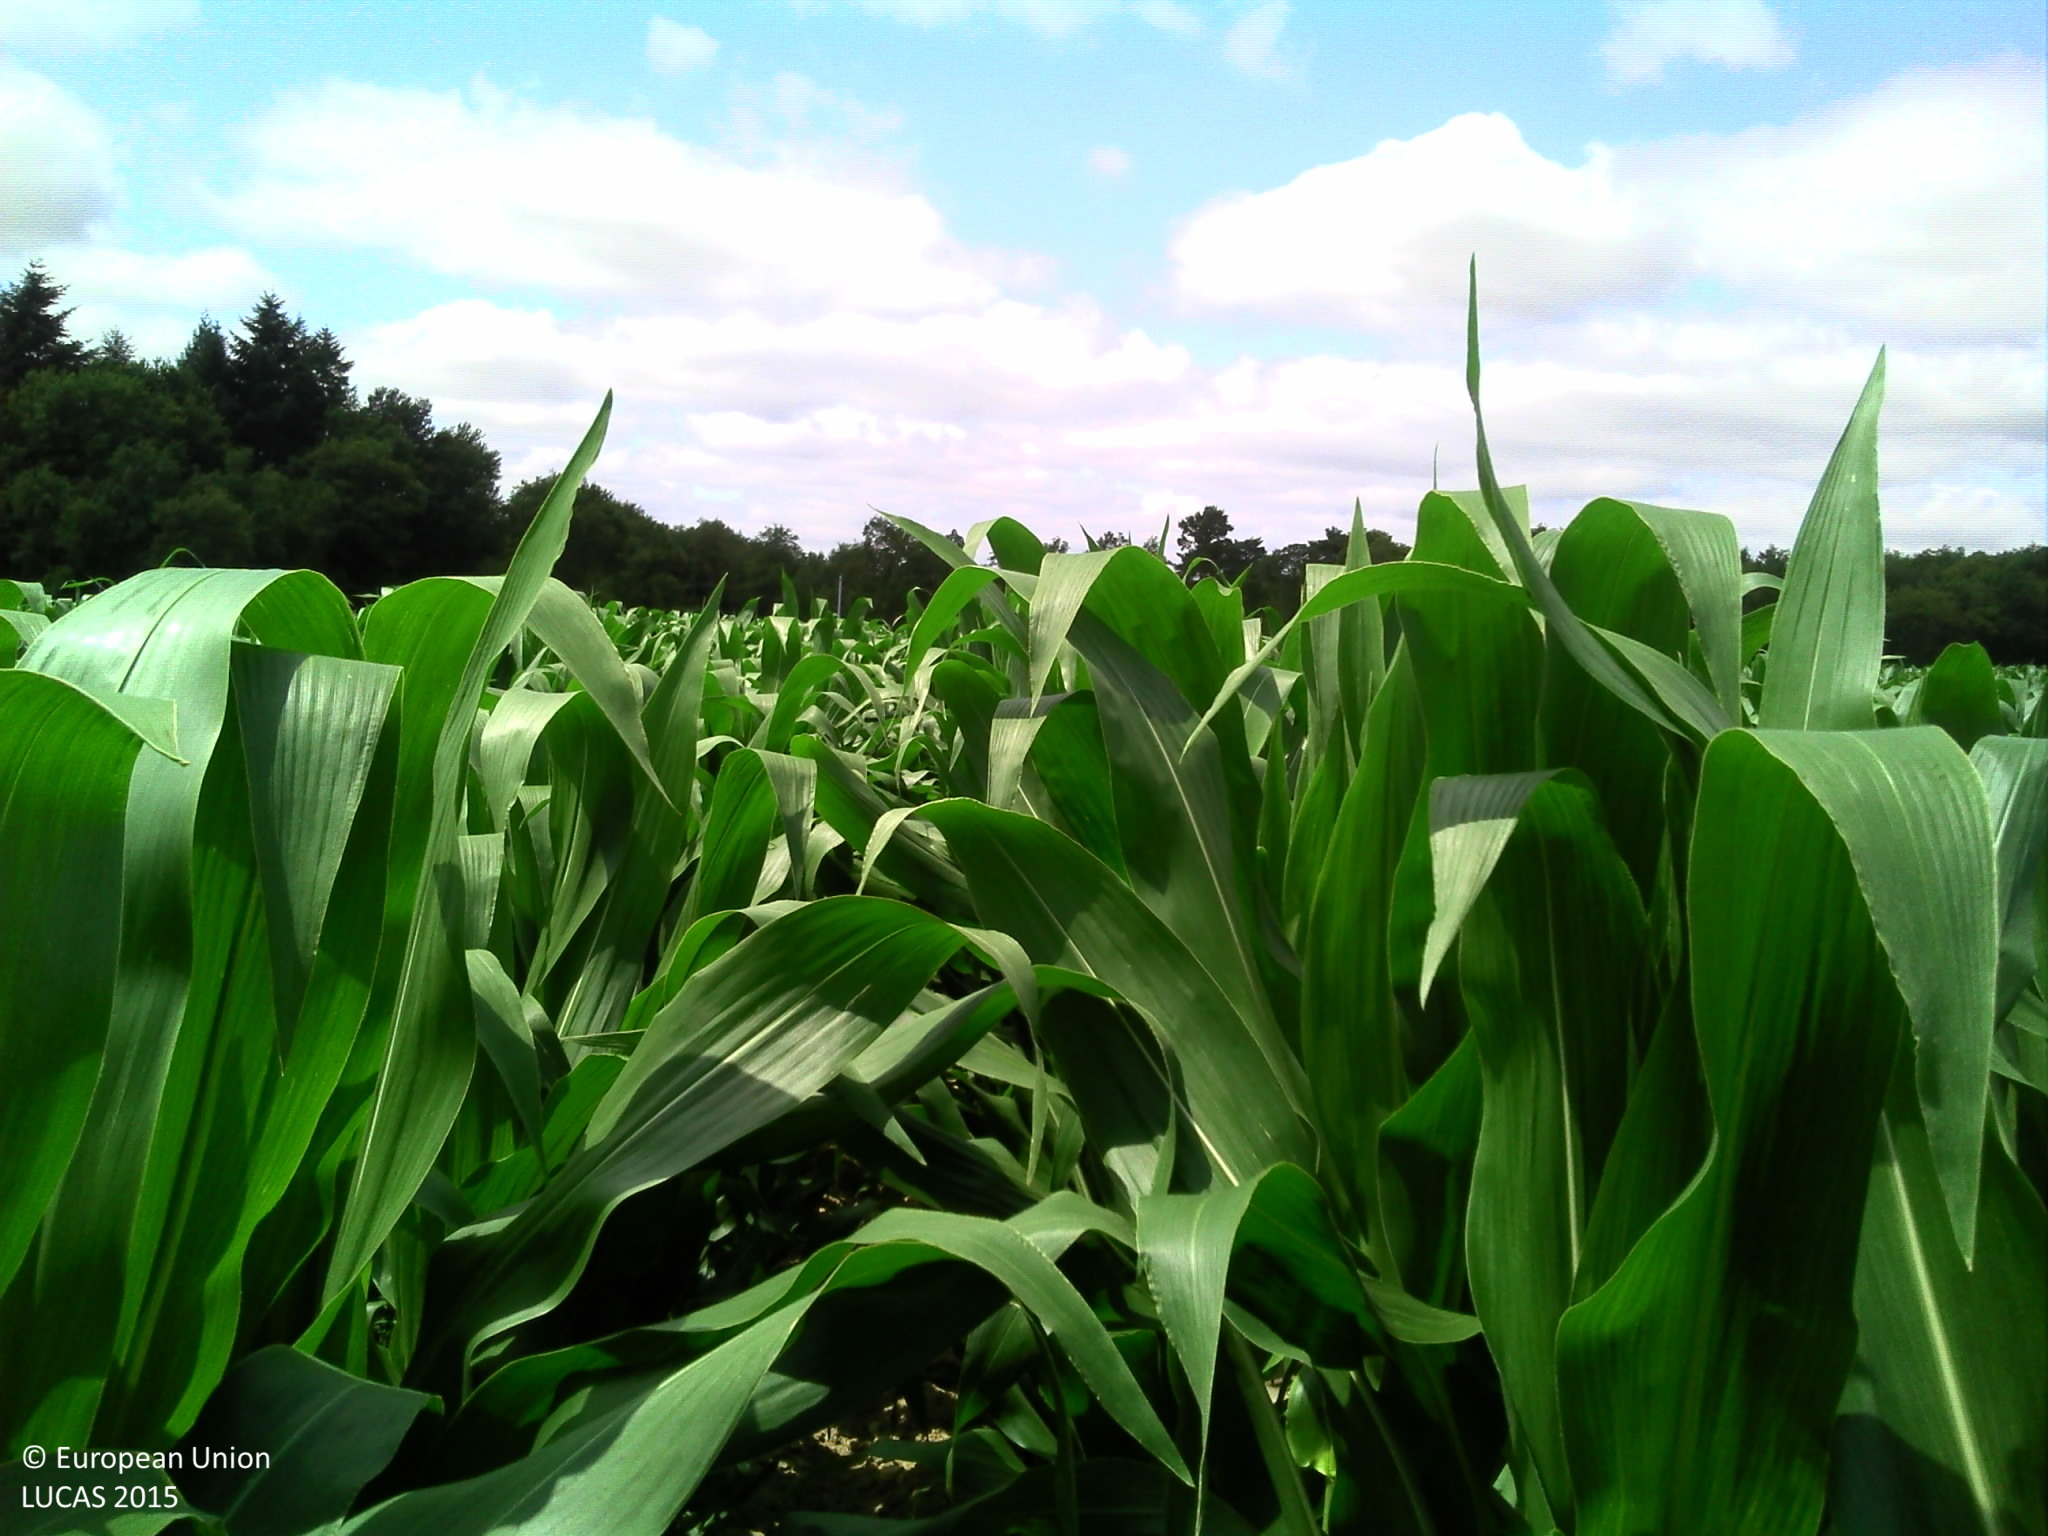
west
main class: Cropland
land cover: Maize
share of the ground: 50 - 75 %
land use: Agriculture (excluding fallow land and kitchen gardens)
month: July
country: FR
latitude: 47.6566
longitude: -1.8315
